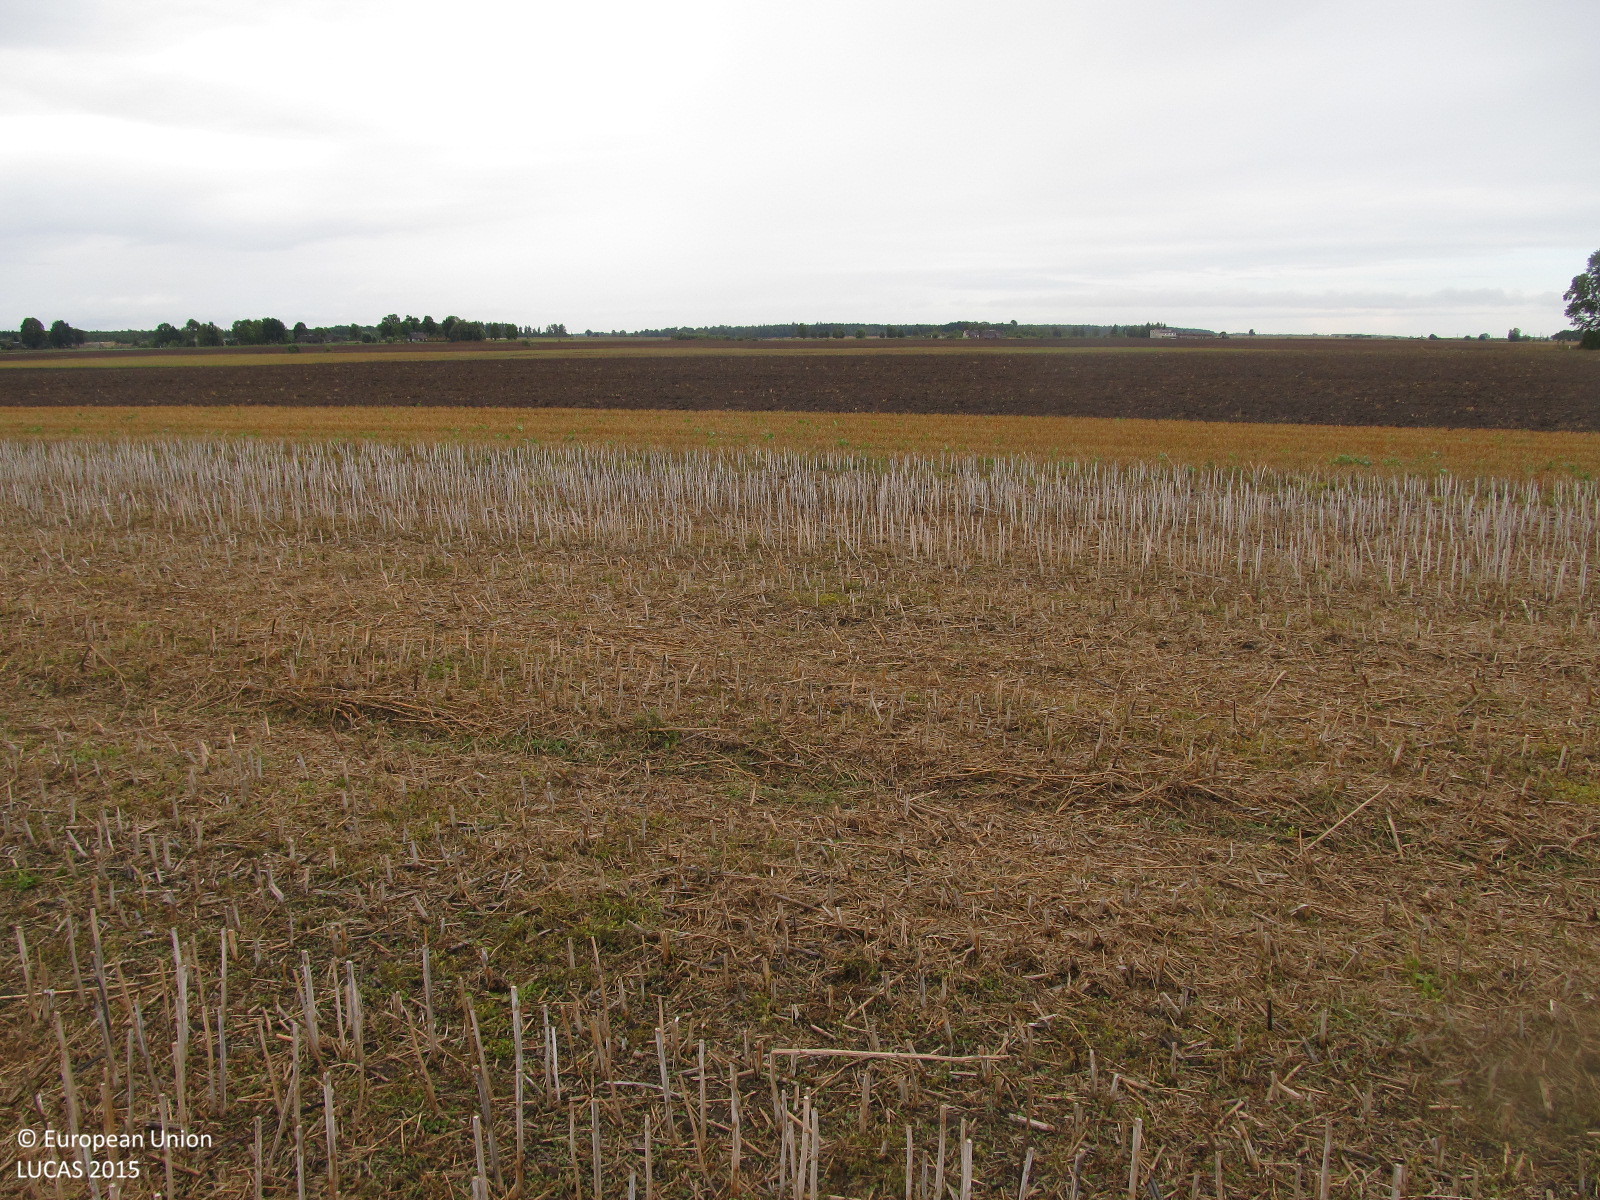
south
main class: Cropland
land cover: Rape and turnip rape
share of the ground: > 75 %
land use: Agriculture (excluding fallow land and kitchen gardens)
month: September
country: LT
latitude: 56.1034
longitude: 23.2067
